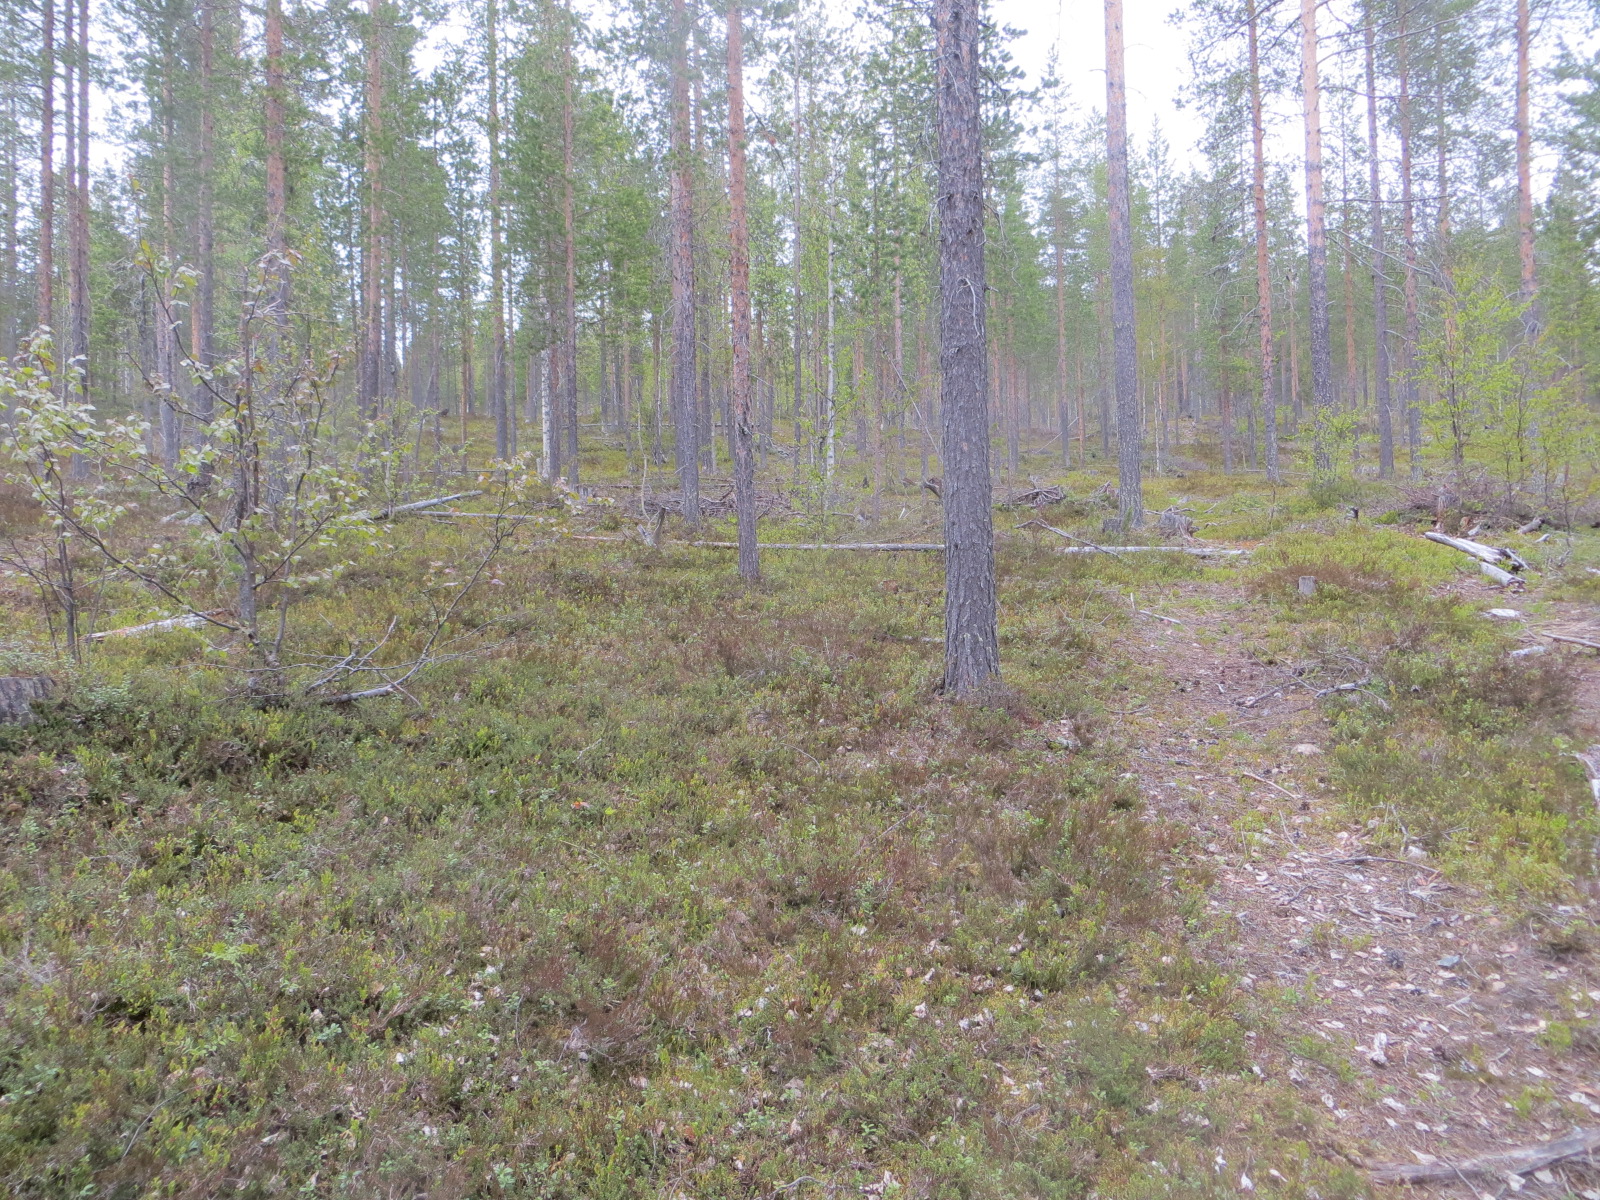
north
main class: Woodland
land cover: Pine dominated coniferous woodland
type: boreal forest
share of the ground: 50 - 75 %
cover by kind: coniferous forest trees 65 %, shrubs 15 %, broadleaved forest trees 10 %, herbaceous plants 5 %, lichens and mosses 5 %
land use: Forestry
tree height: > 5 m
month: June
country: FI
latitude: 67.5705
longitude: 25.7657
